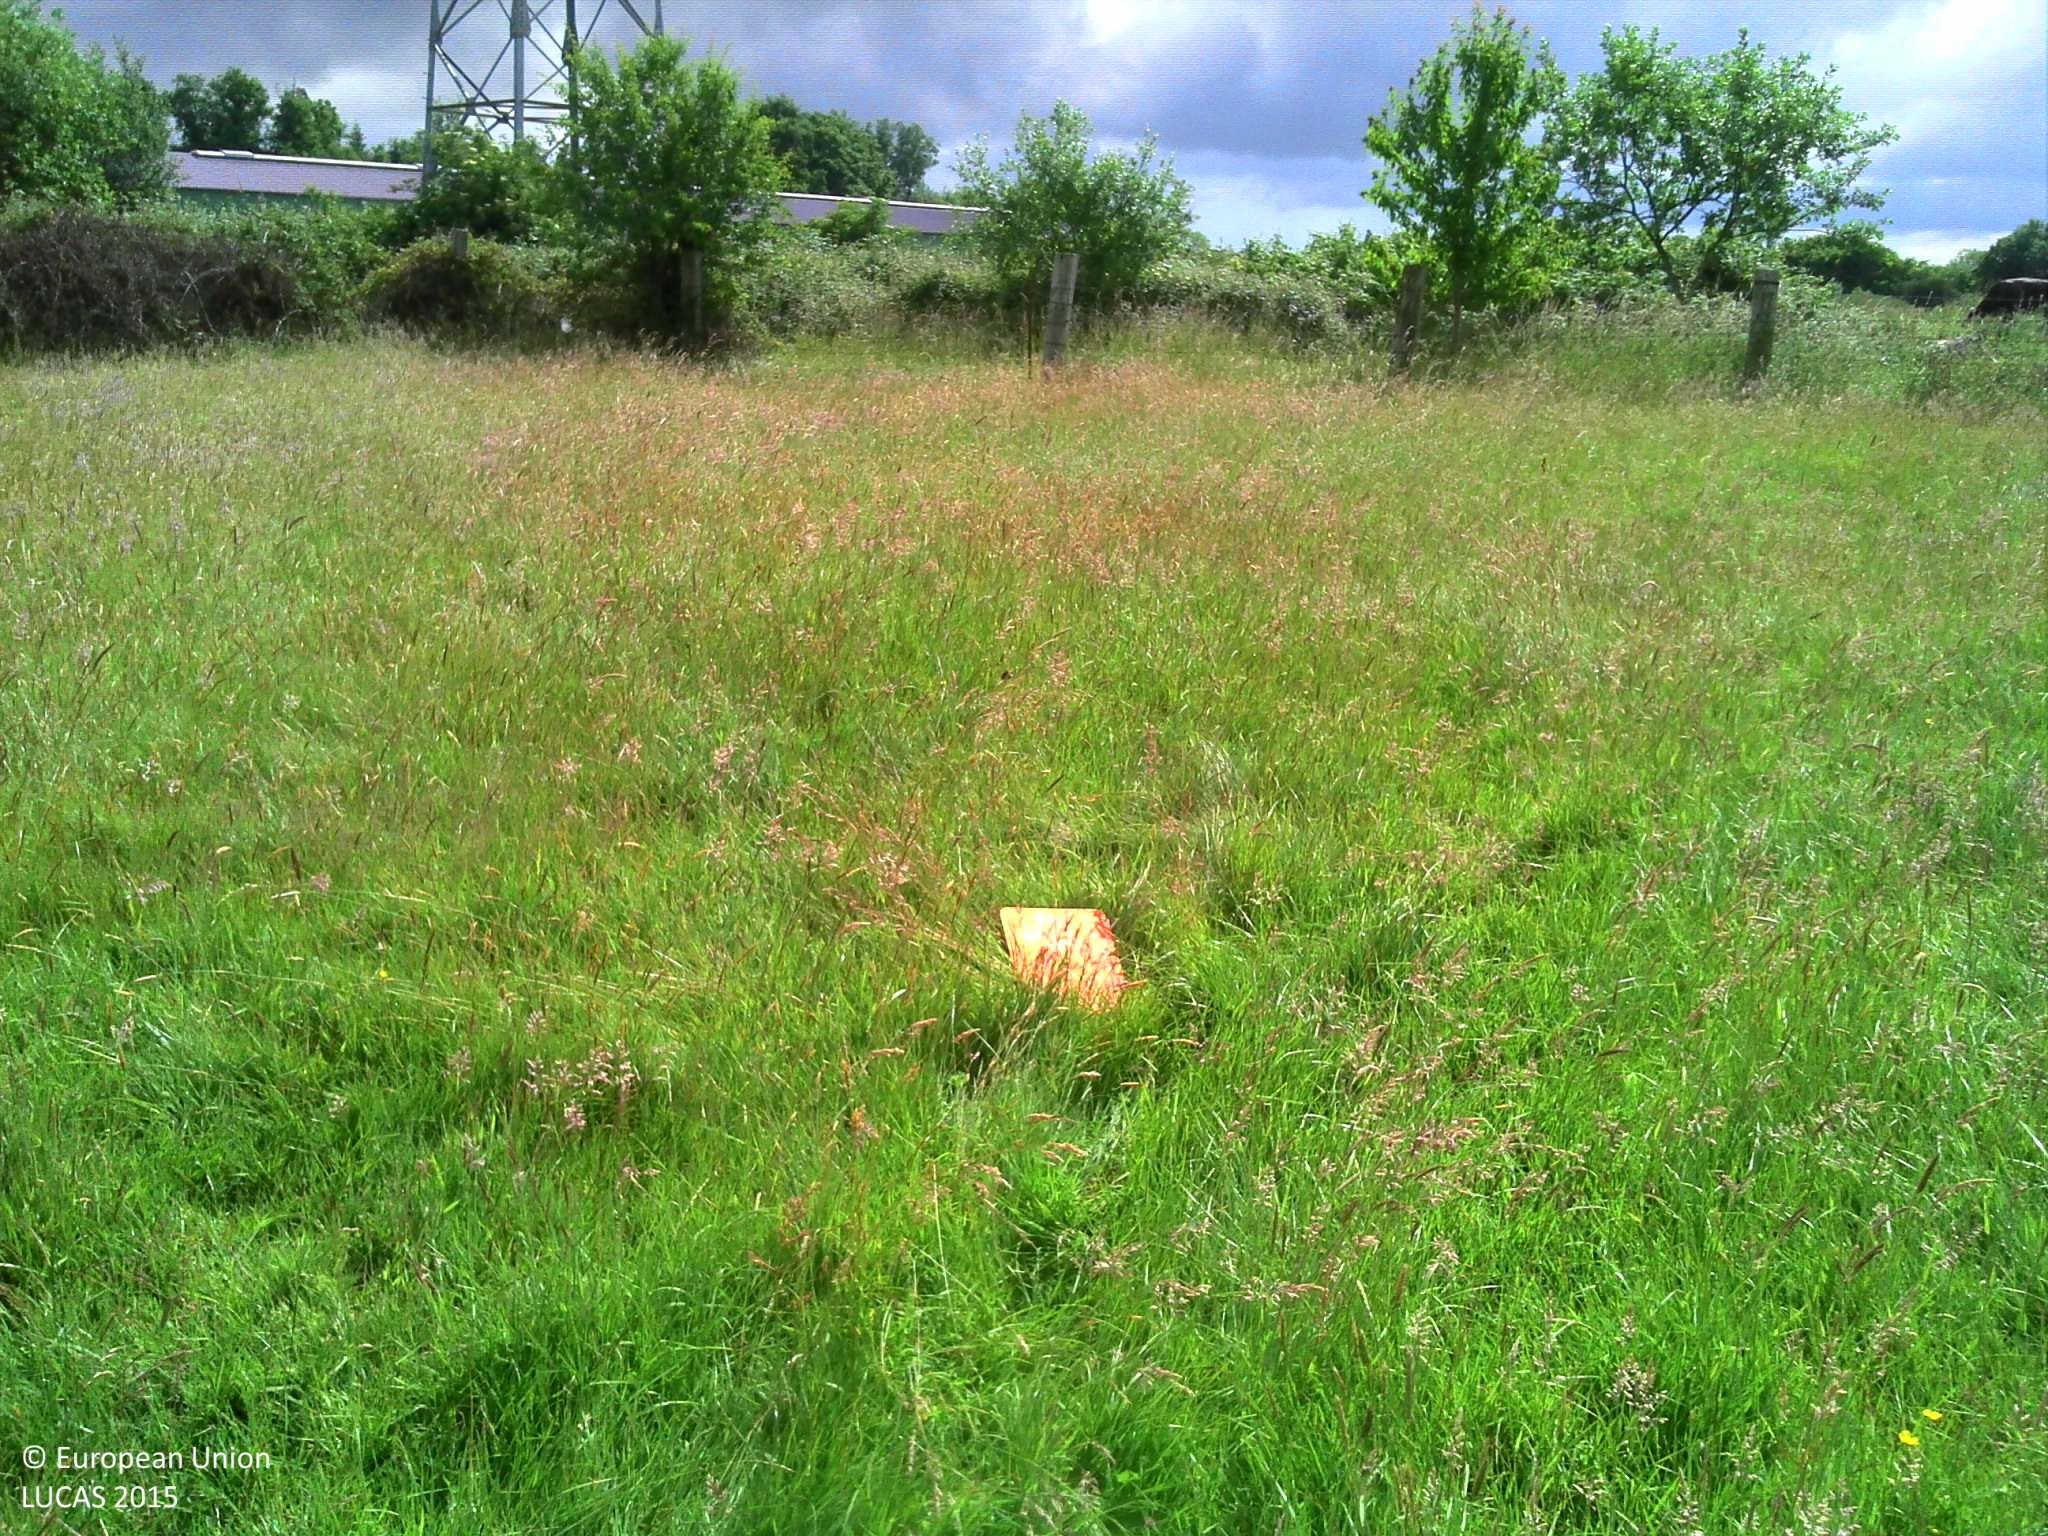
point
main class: Grassland
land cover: Grassland without tree/shrub cover
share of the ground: > 75 %
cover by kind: herbaceous plants 100 %
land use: Agriculture (excluding fallow land and kitchen gardens)
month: June
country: FR
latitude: 49.0165
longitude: 0.3880
